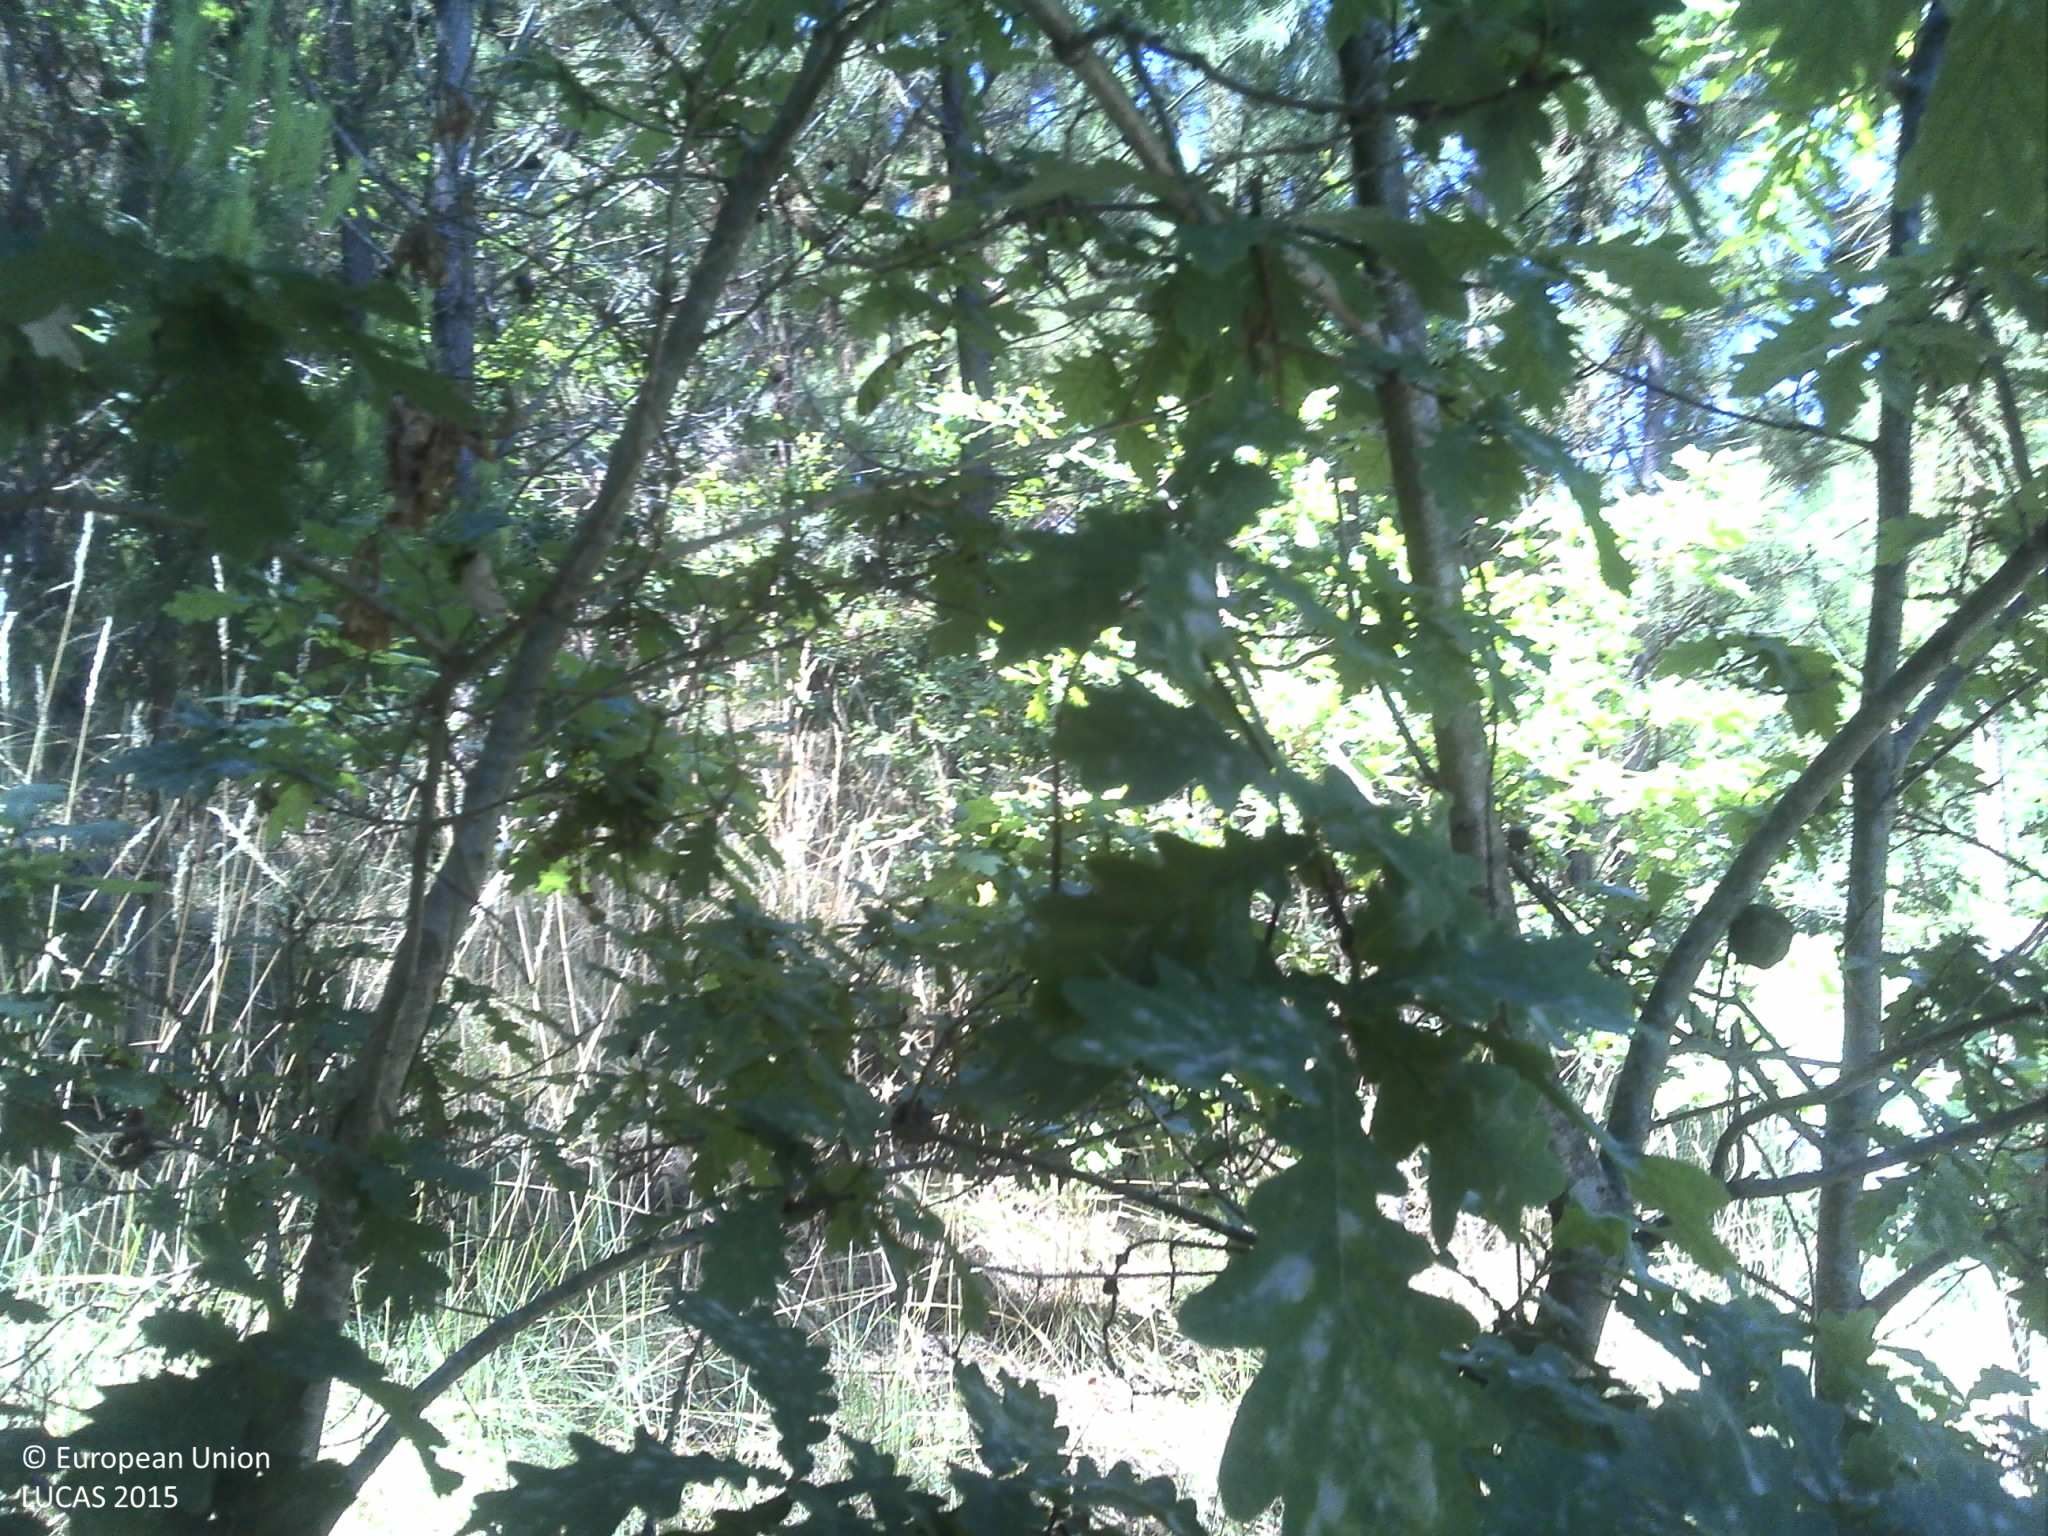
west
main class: Woodland
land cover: Pine dominated coniferous woodland
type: coniferous forest of the mediterranean region
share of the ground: > 75 %
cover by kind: coniferous forest trees 75 %, shrubs 15 %, broadleaved forest trees 5 %, unconsolidated bare surface 5 %
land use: Forestry
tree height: > 5 m
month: June
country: PT
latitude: 41.4089
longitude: -8.0242
